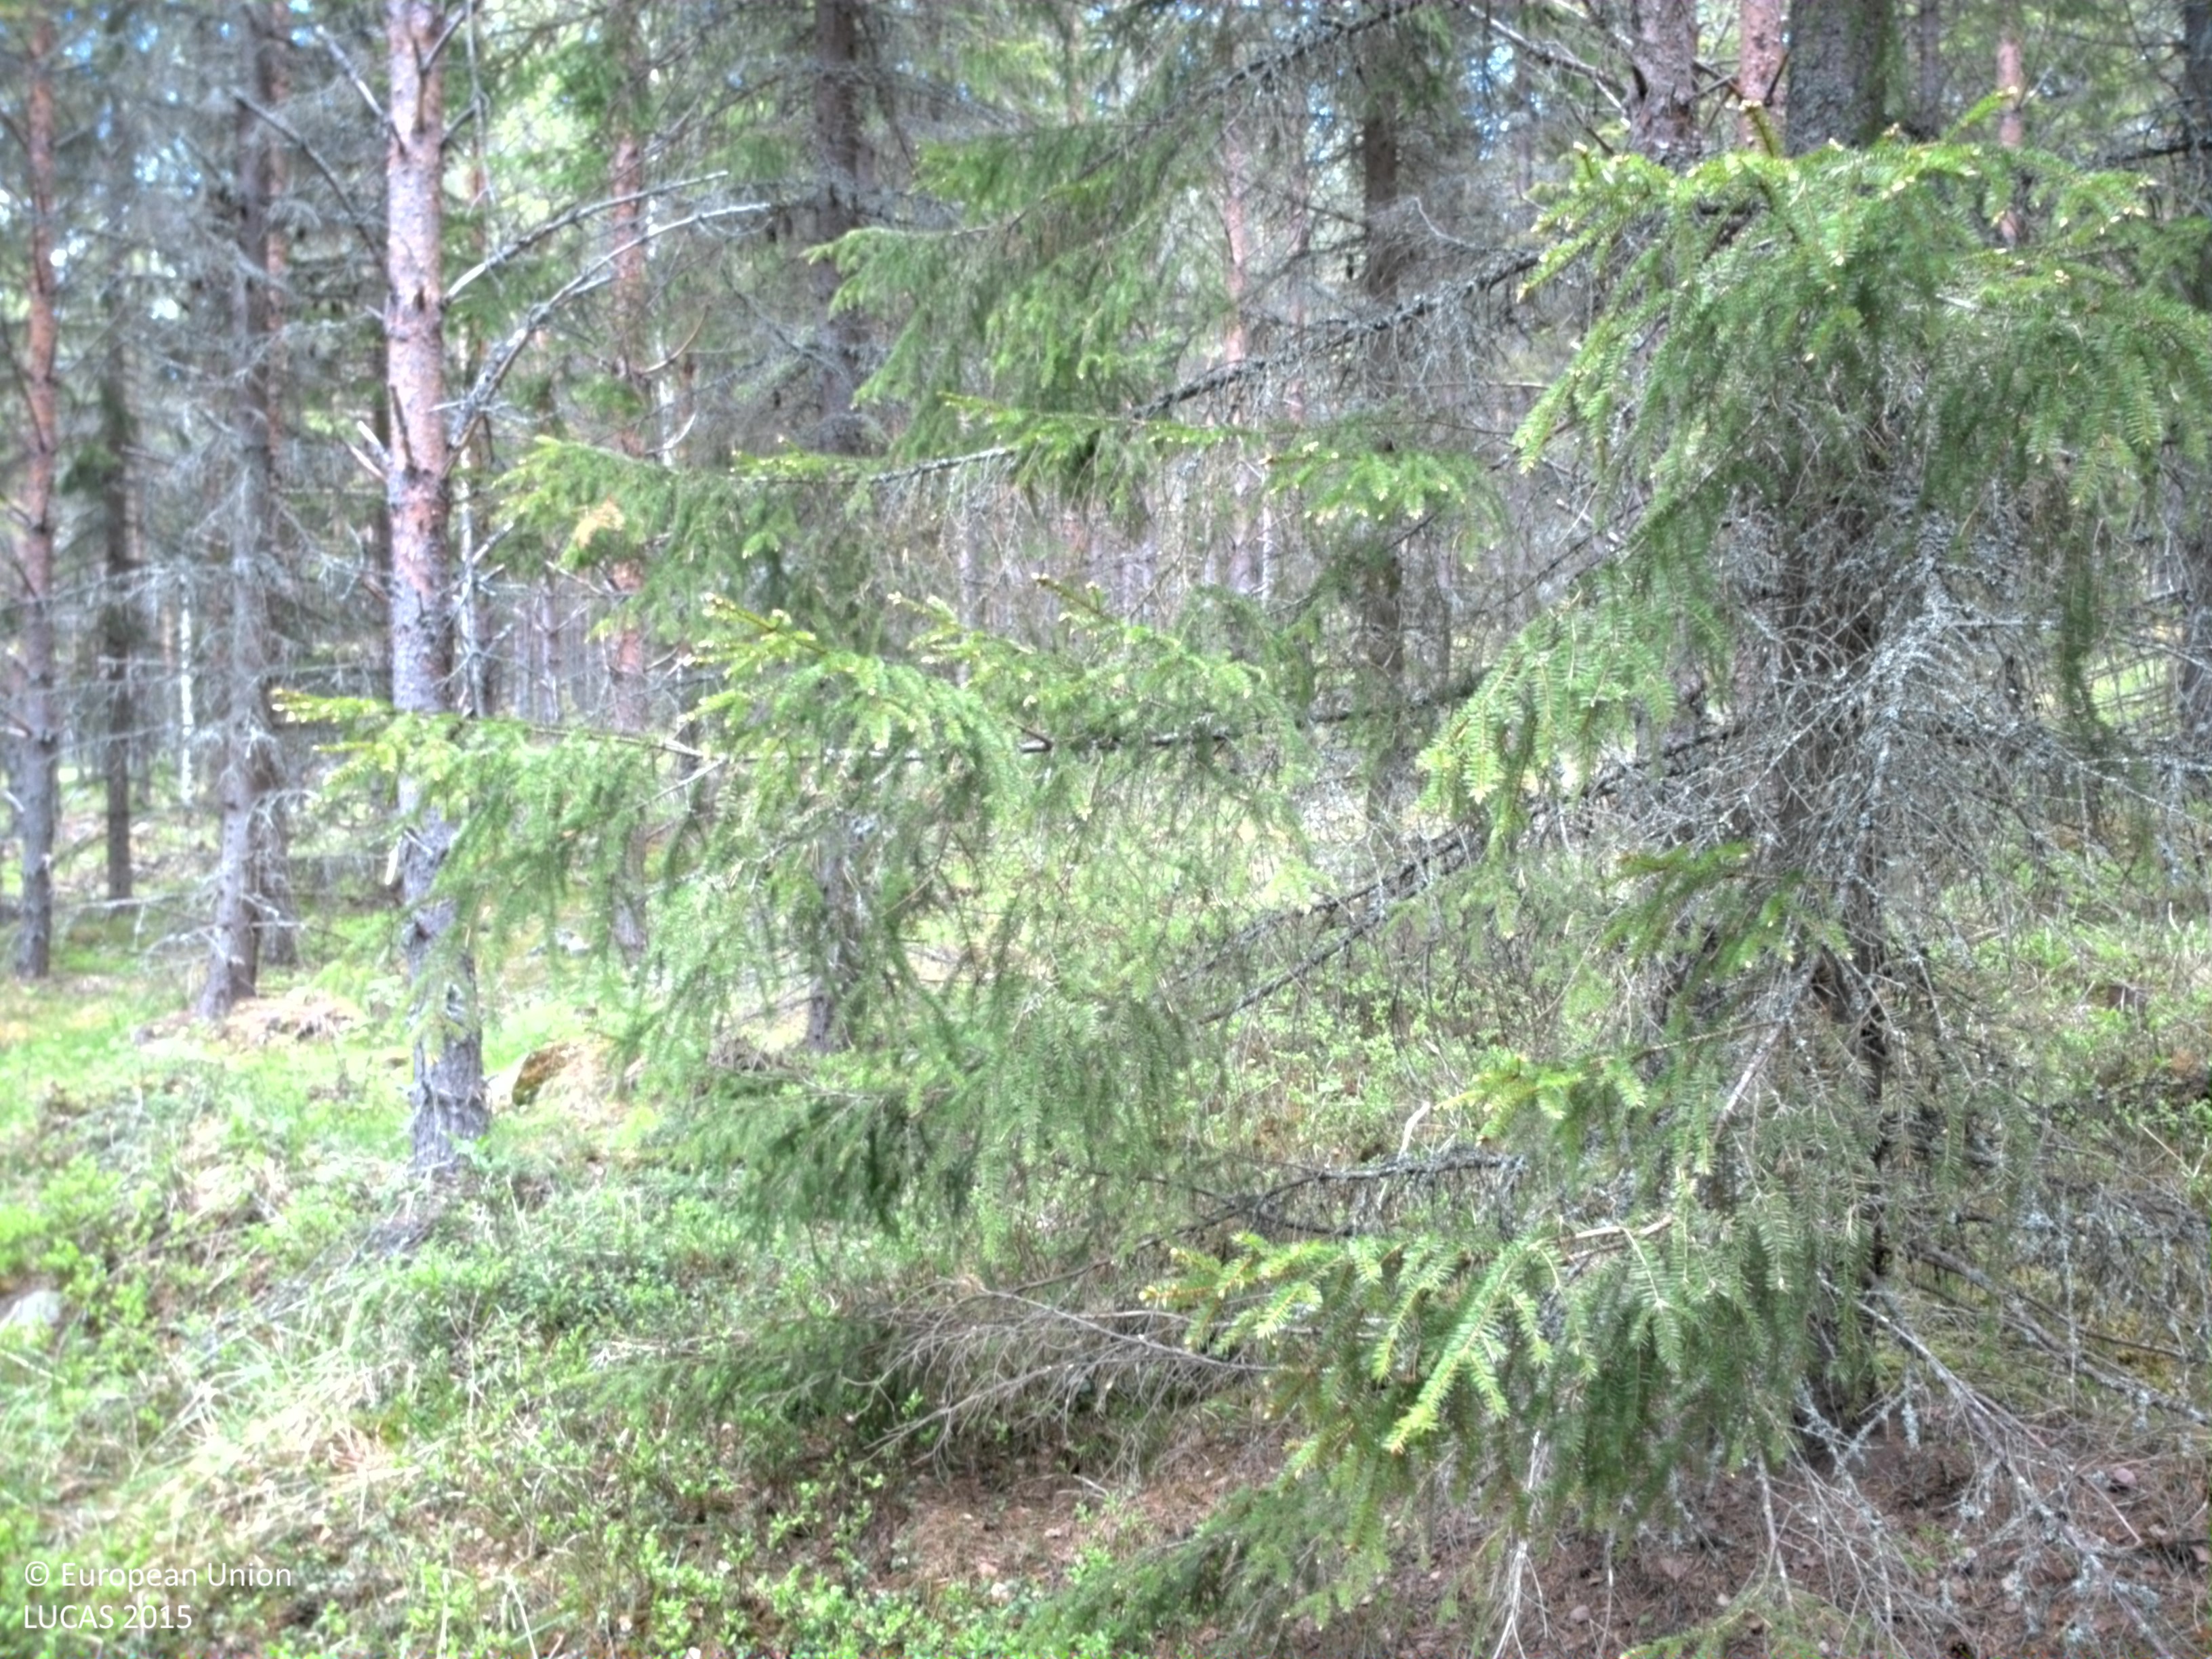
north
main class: Woodland
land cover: Pine dominated coniferous woodland
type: boreal forest
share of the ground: 50 - 75 %
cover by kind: coniferous forest trees 65 %, herbaceous plants 30 %, lichens and mosses 5 %
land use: Forestry
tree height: > 5 m
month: May
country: SE
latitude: 61.2822
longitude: 15.5258
